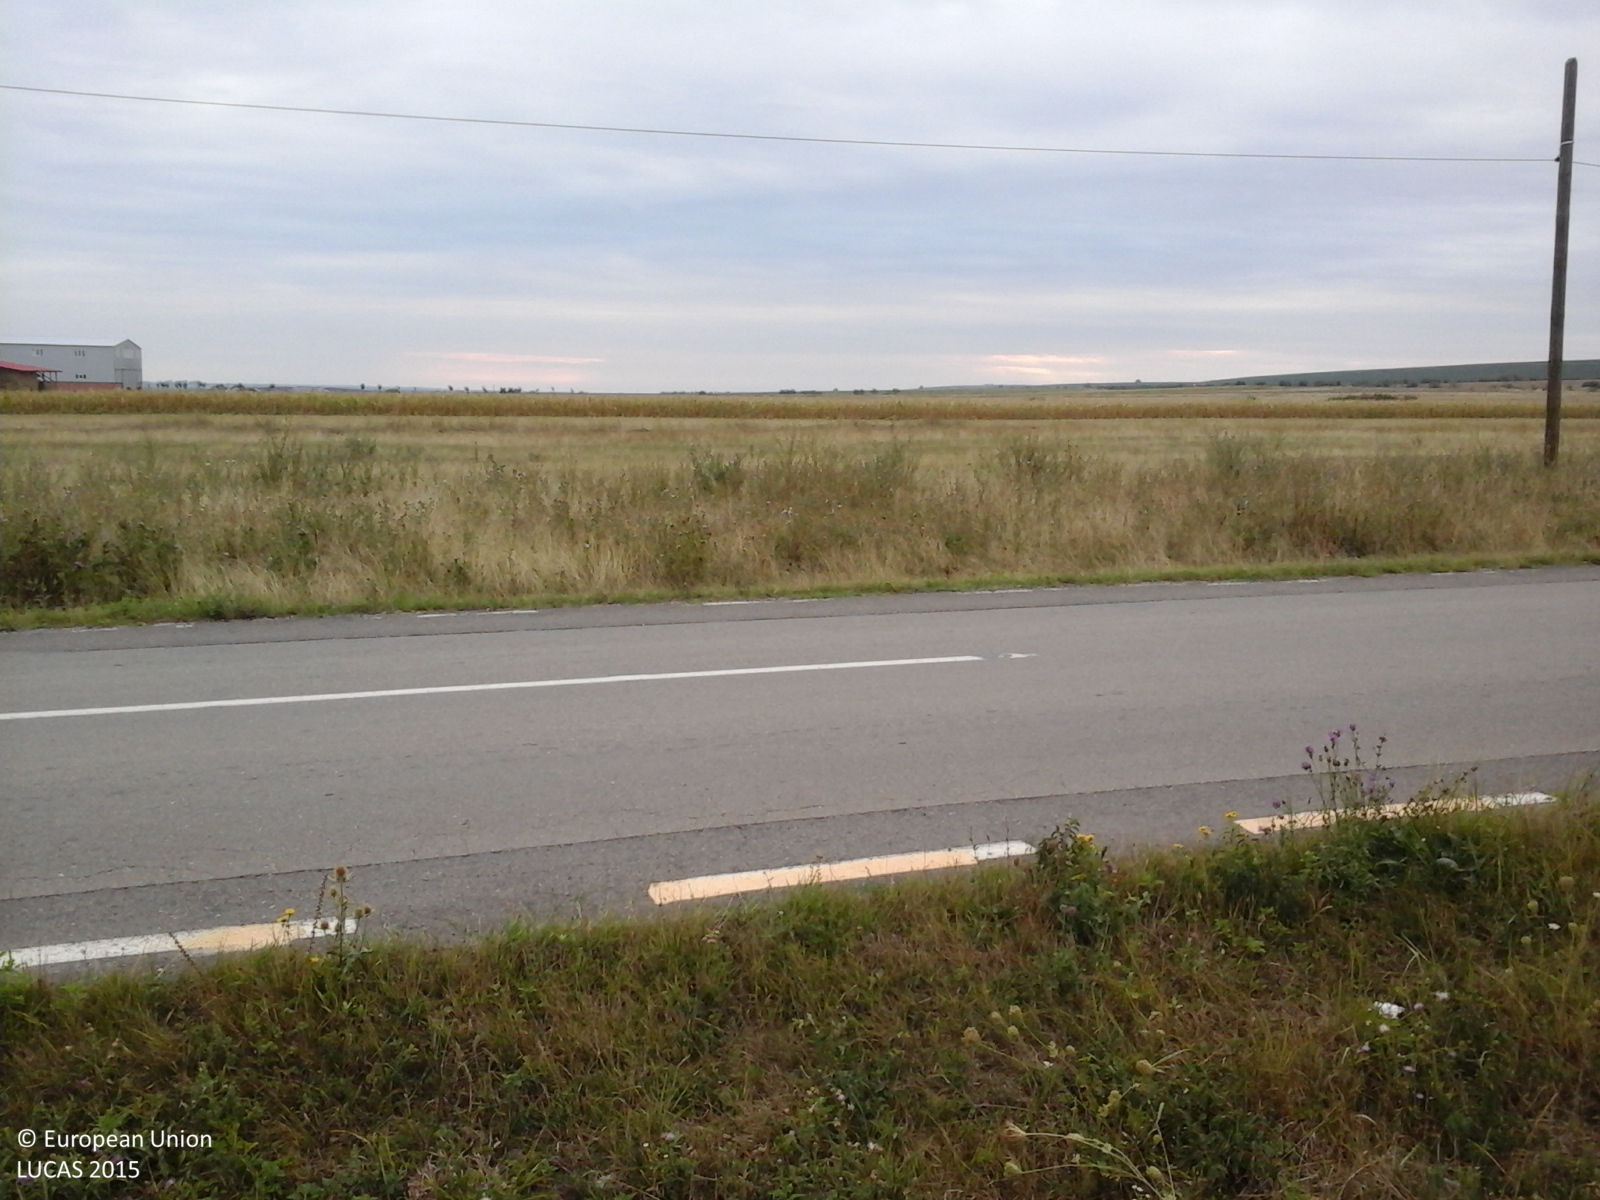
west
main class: Grassland
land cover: Spontaneously vegetated surfaces
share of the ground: > 75 %
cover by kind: herbaceous plants 100 %
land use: Fallow land
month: August
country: RO
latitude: 45.8167
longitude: 21.5273
